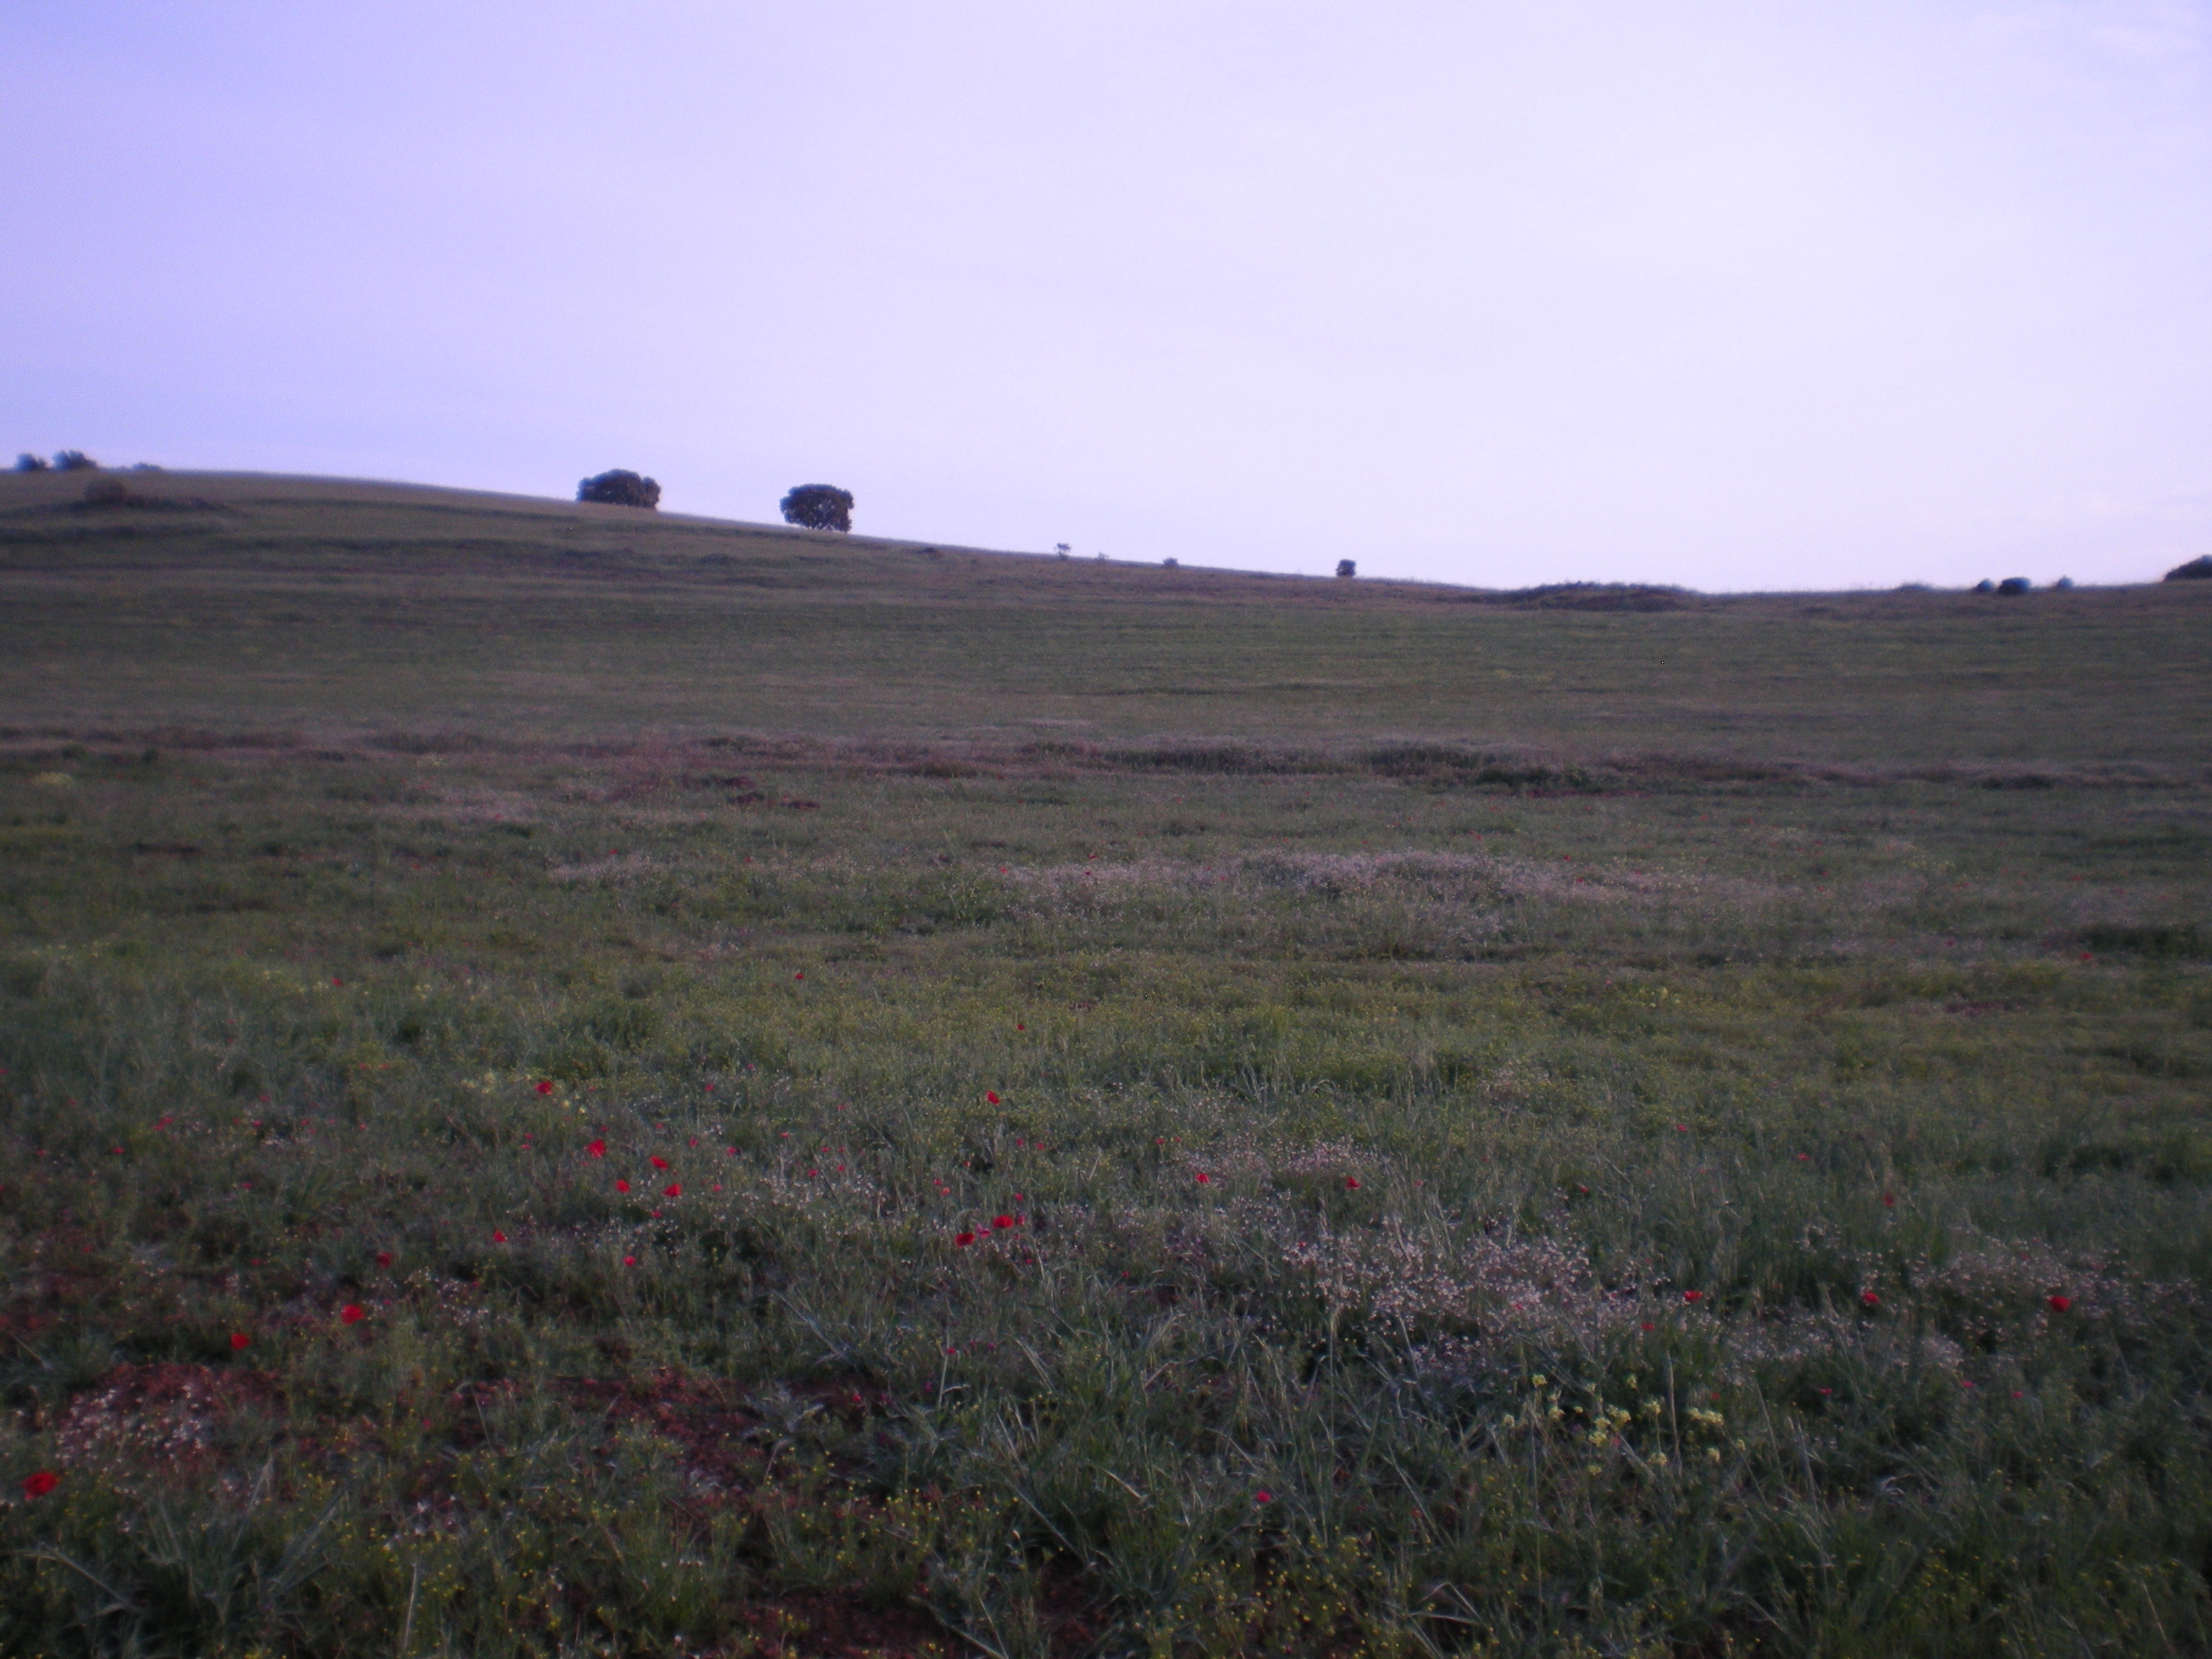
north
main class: Grassland
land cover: Spontaneously vegetated surfaces
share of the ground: > 75 %
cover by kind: herbaceous plants 95 %, unconsolidated bare surface 5 %
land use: Fallow land
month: April
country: ES
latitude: 38.7599
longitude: -3.5111
